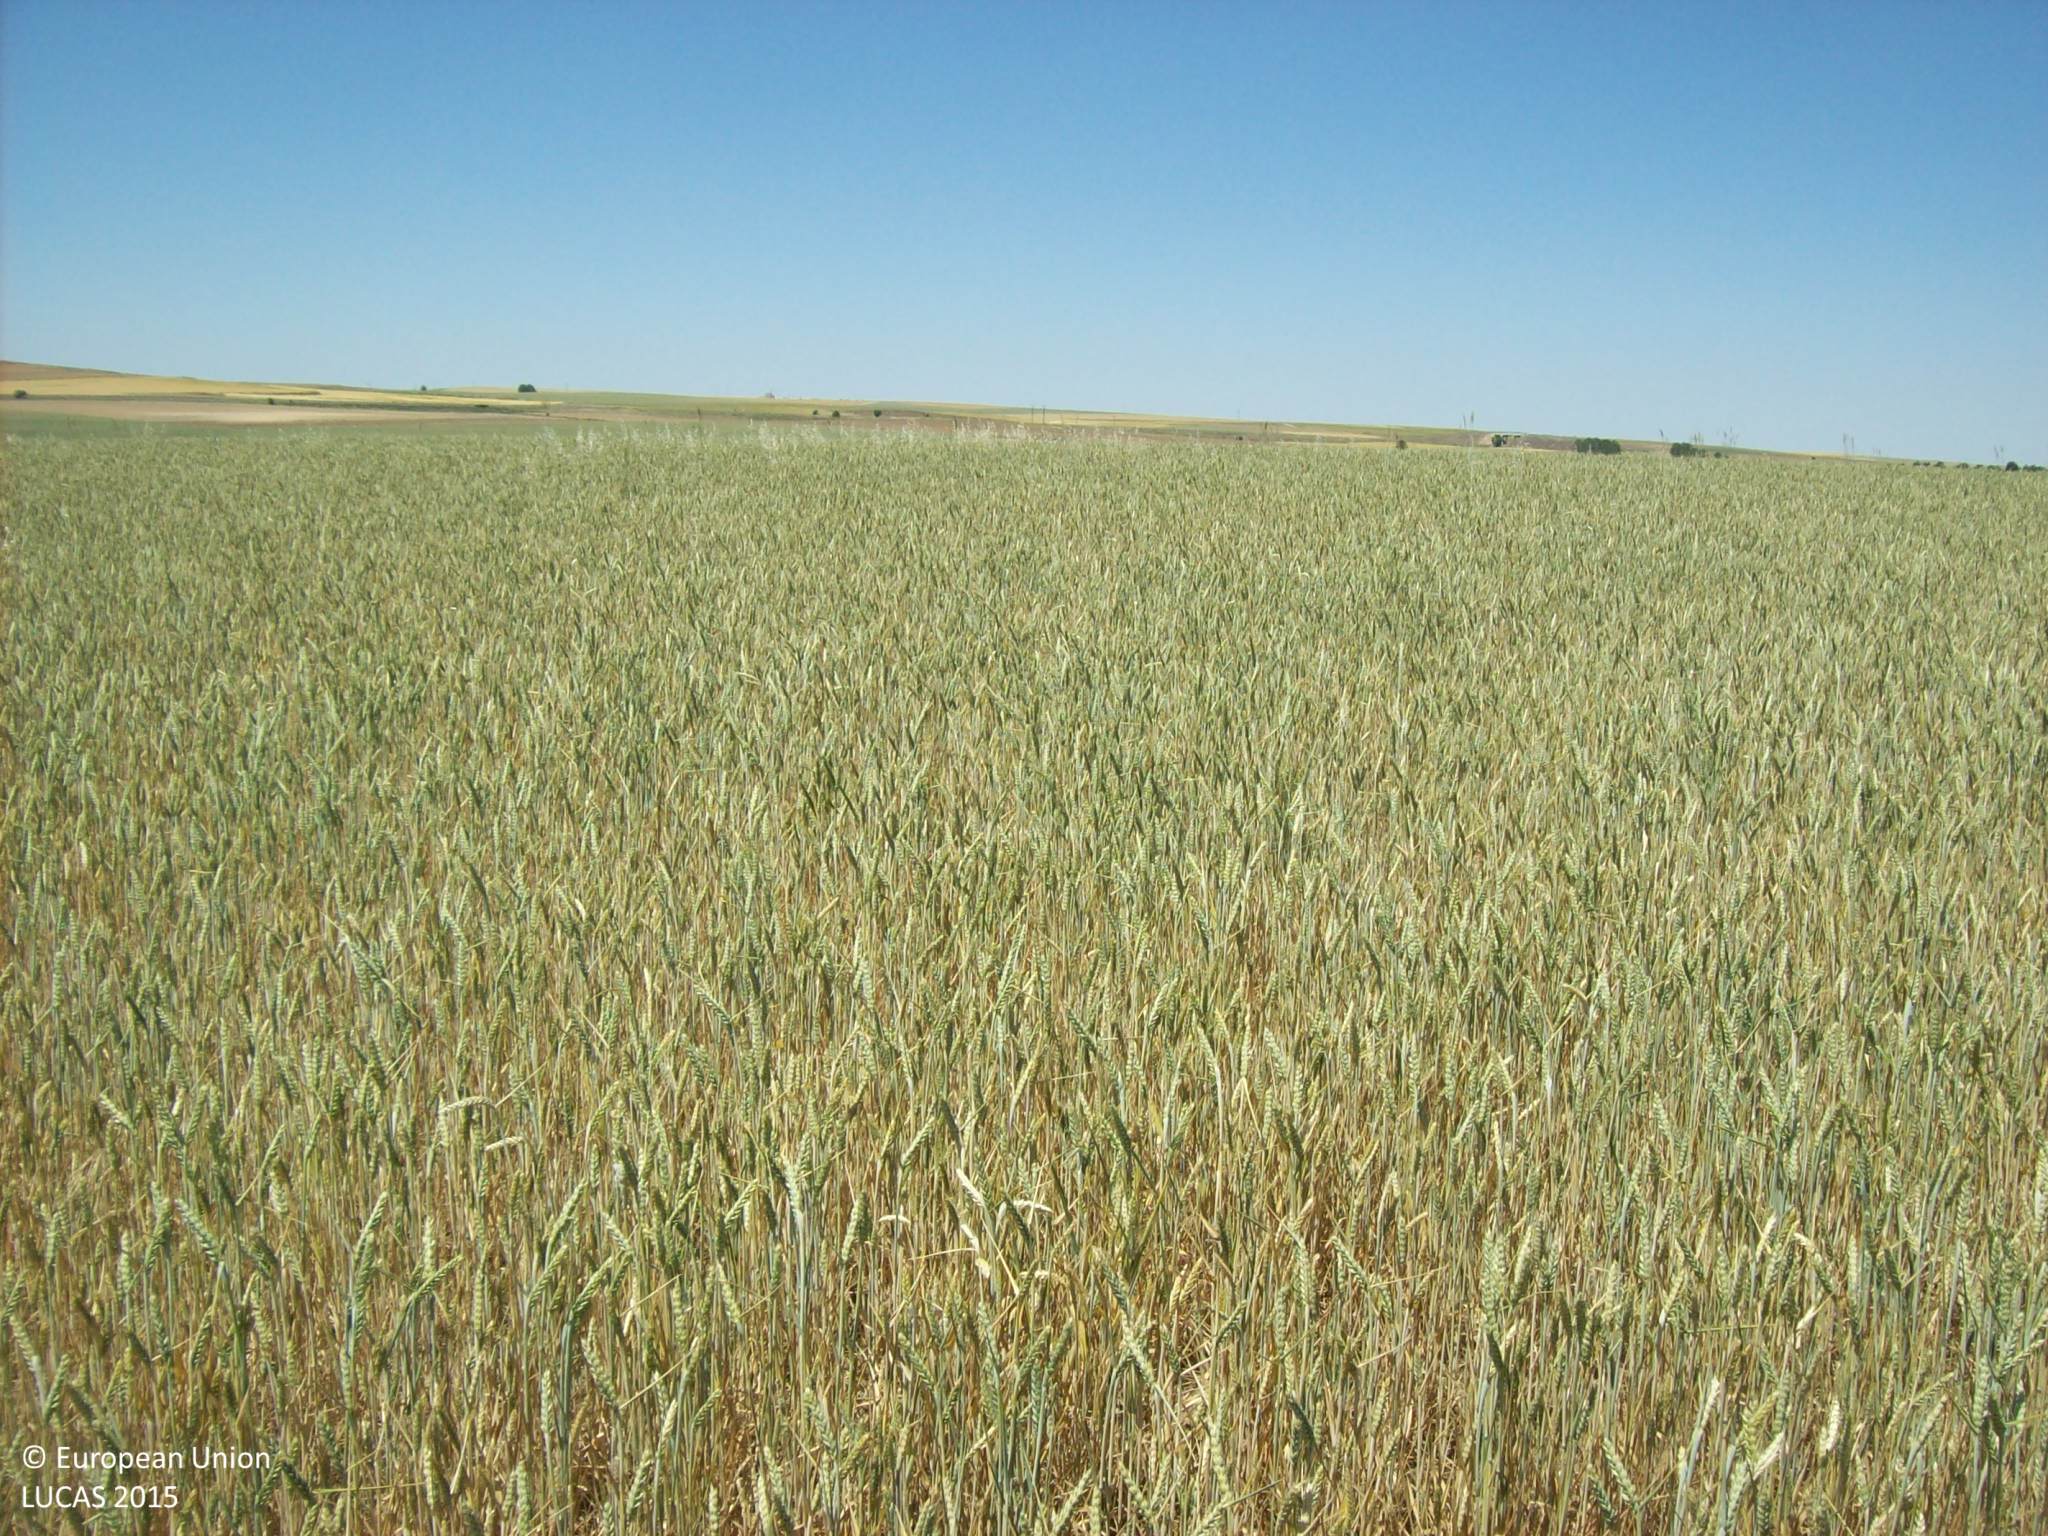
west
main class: Cropland
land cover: Common wheat
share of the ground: > 75 %
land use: Agriculture (excluding fallow land and kitchen gardens)
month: May
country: ES
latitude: 40.8443
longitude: -4.9233
